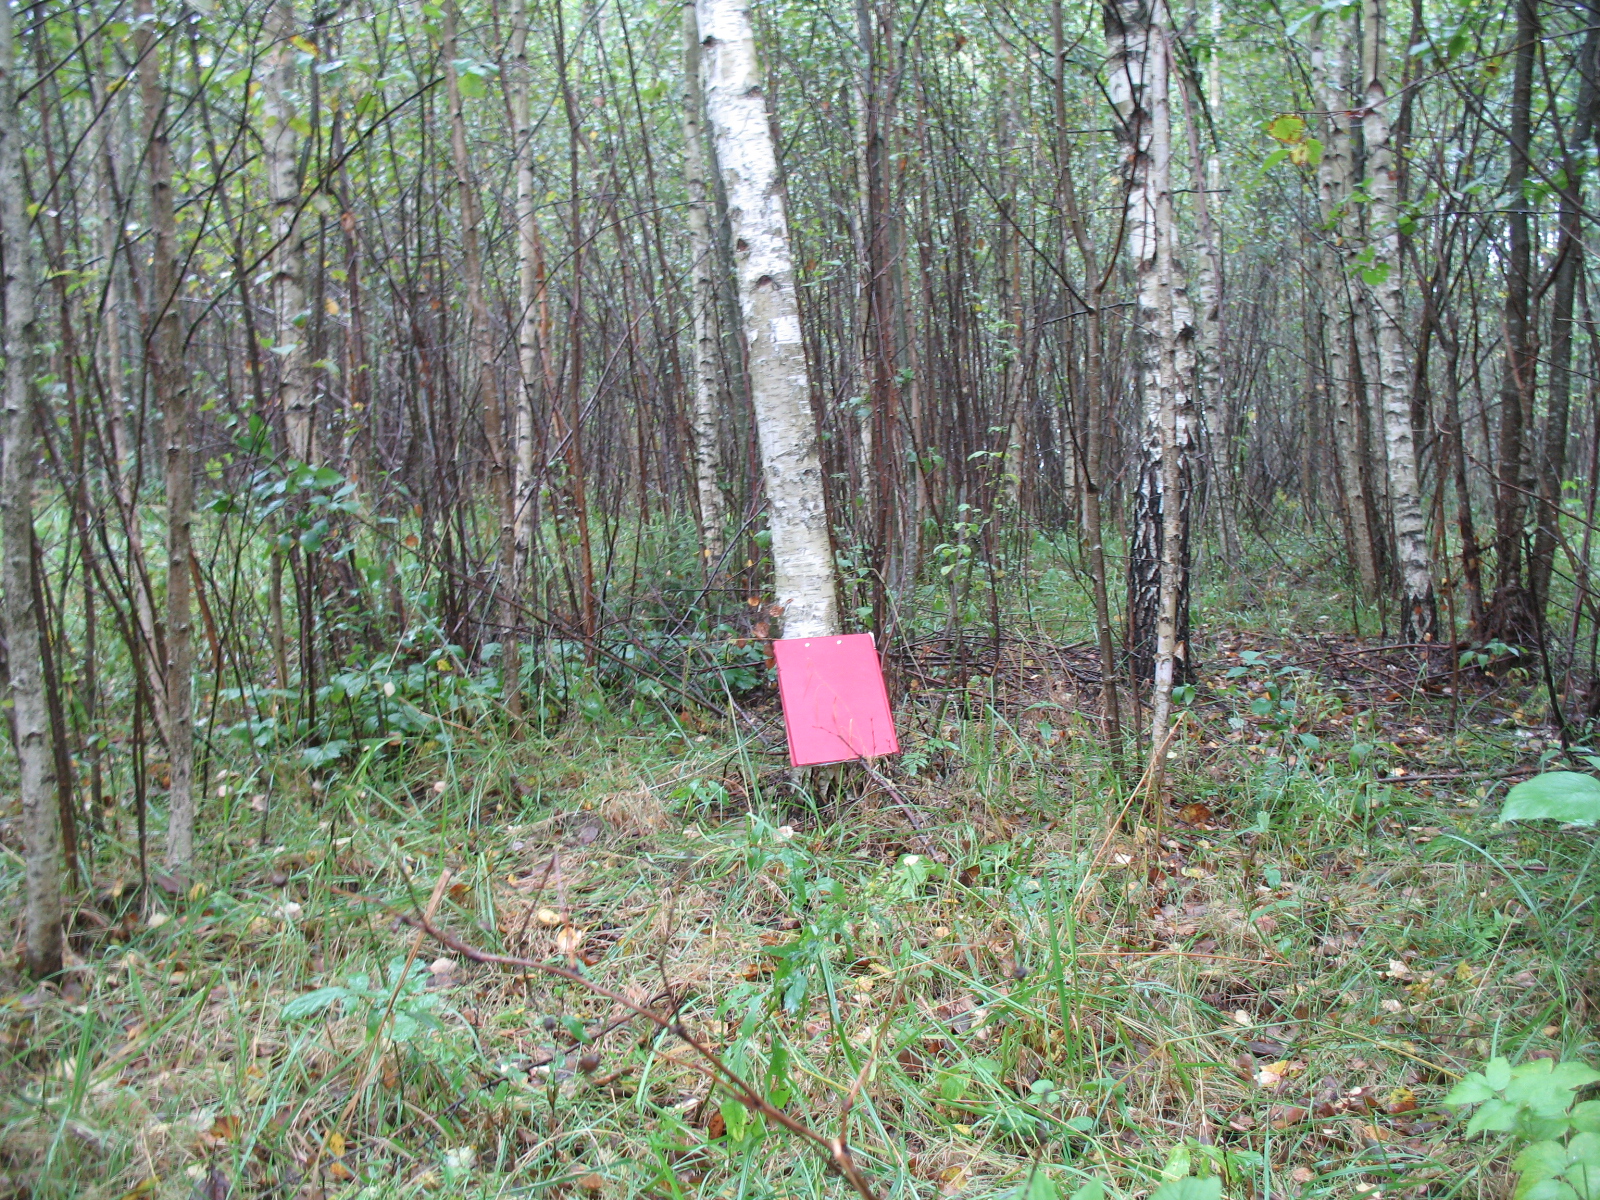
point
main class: Woodland
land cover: Broadleaved woodland
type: non-riverine alder, birch or aspen forest
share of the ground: 50 - 75 %
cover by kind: broadleaved forest trees 70 %, herbaceous plants 30 %
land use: Forestry
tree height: > 5 m
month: September
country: LV
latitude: 56.0174
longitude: 25.8693
